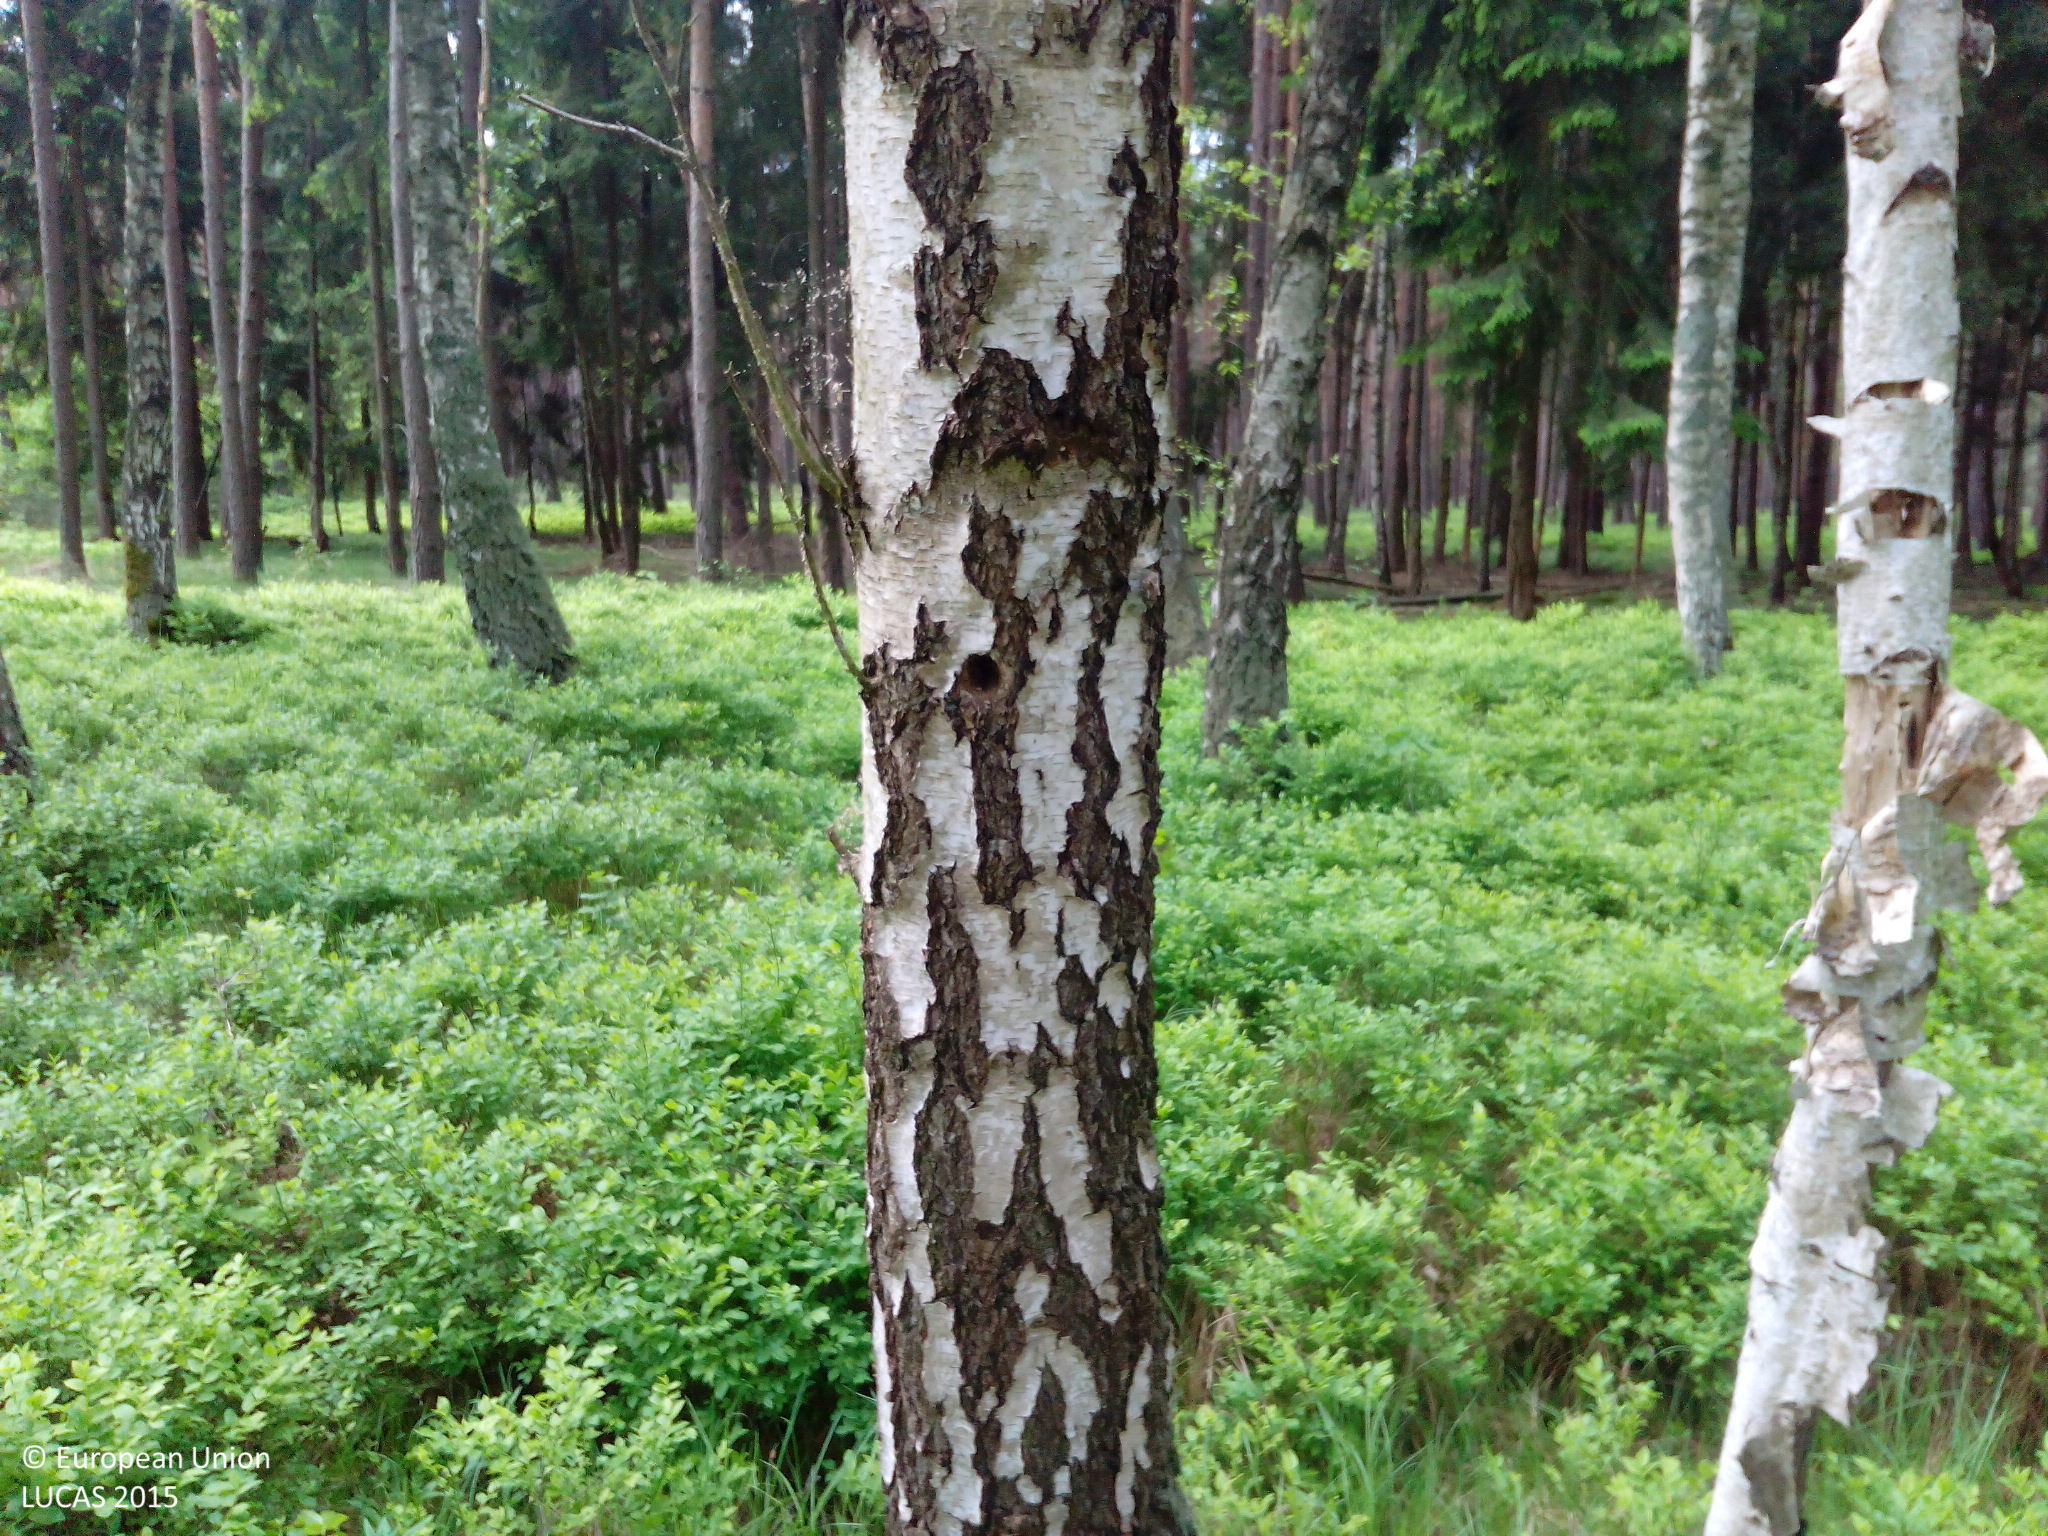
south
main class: Woodland
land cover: Pine dominated mixed woodland
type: hemiboreal forest and nemoral coniferous forest and mixed broadleaved-coniferous forest
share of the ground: > 75 %
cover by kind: coniferous forest trees 70 %, broadleaved forest trees 30 %
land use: Forestry
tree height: > 5 m
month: May
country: DE
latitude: 51.8205
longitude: 13.5548
